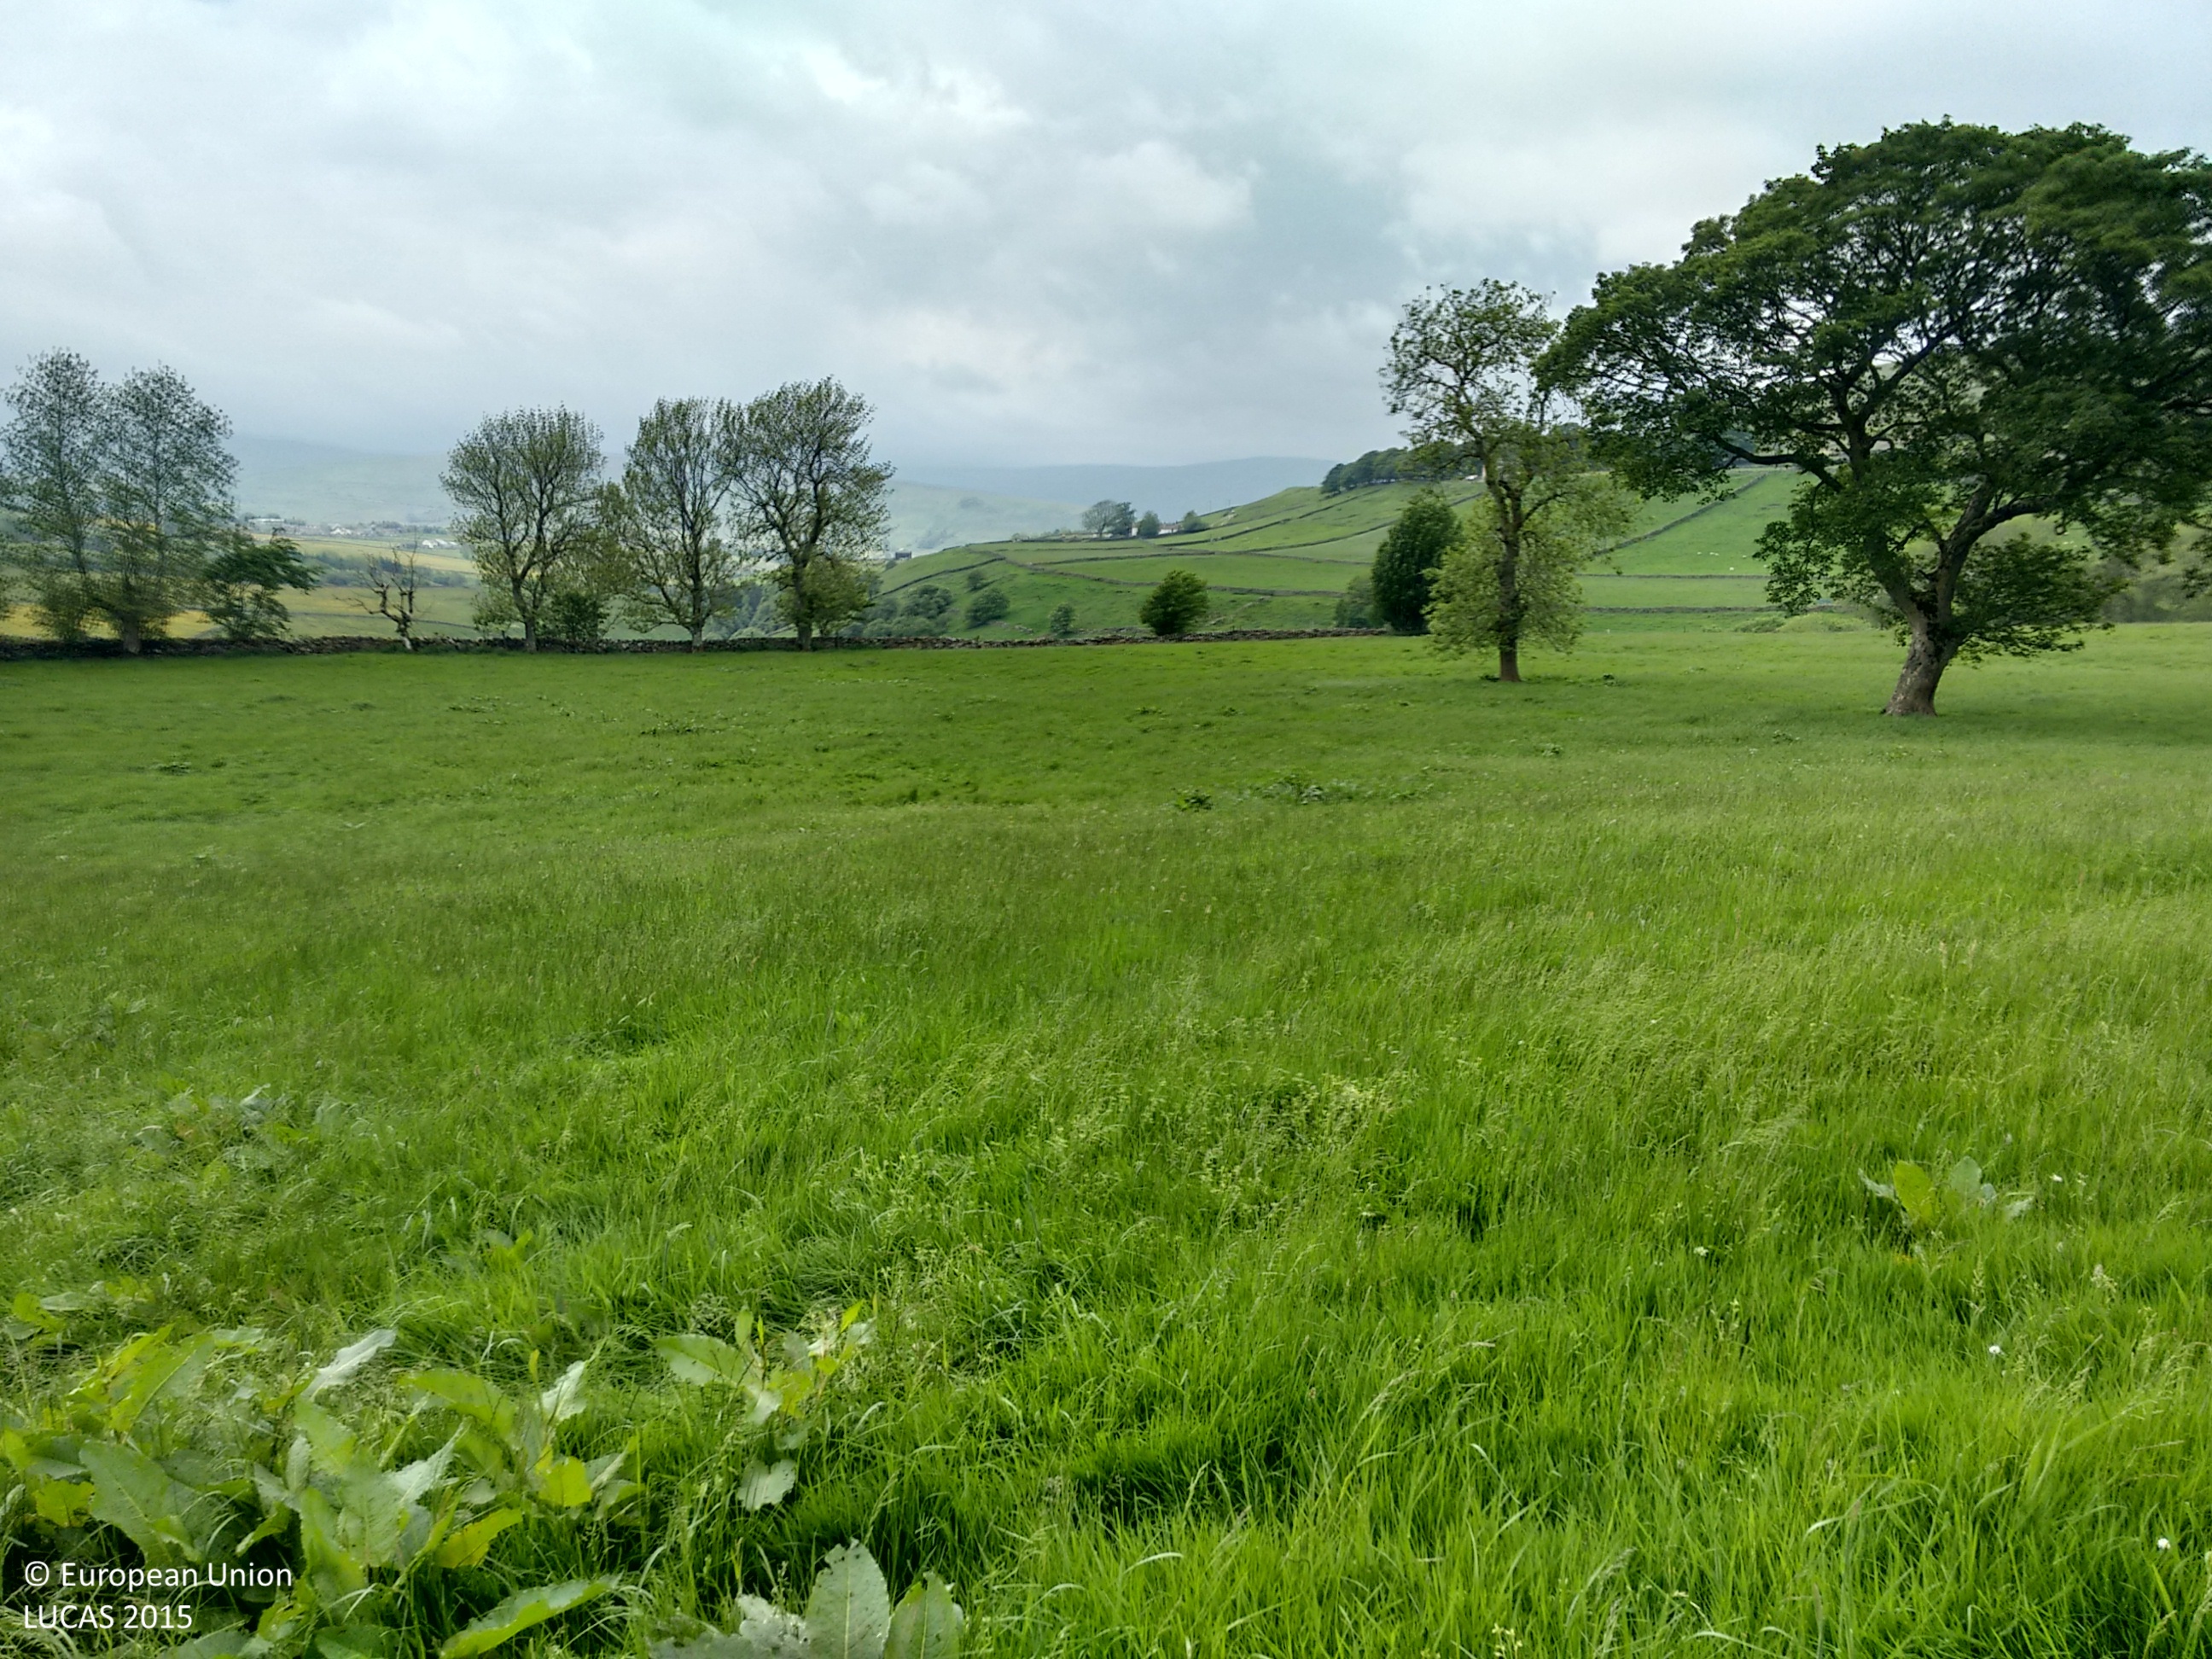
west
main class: Grassland
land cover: Grassland without tree/shrub cover
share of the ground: > 75 %
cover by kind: herbaceous plants 100 %
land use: Agriculture (excluding fallow land and kitchen gardens)
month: June
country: GB
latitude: 54.8183
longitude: -2.4026
